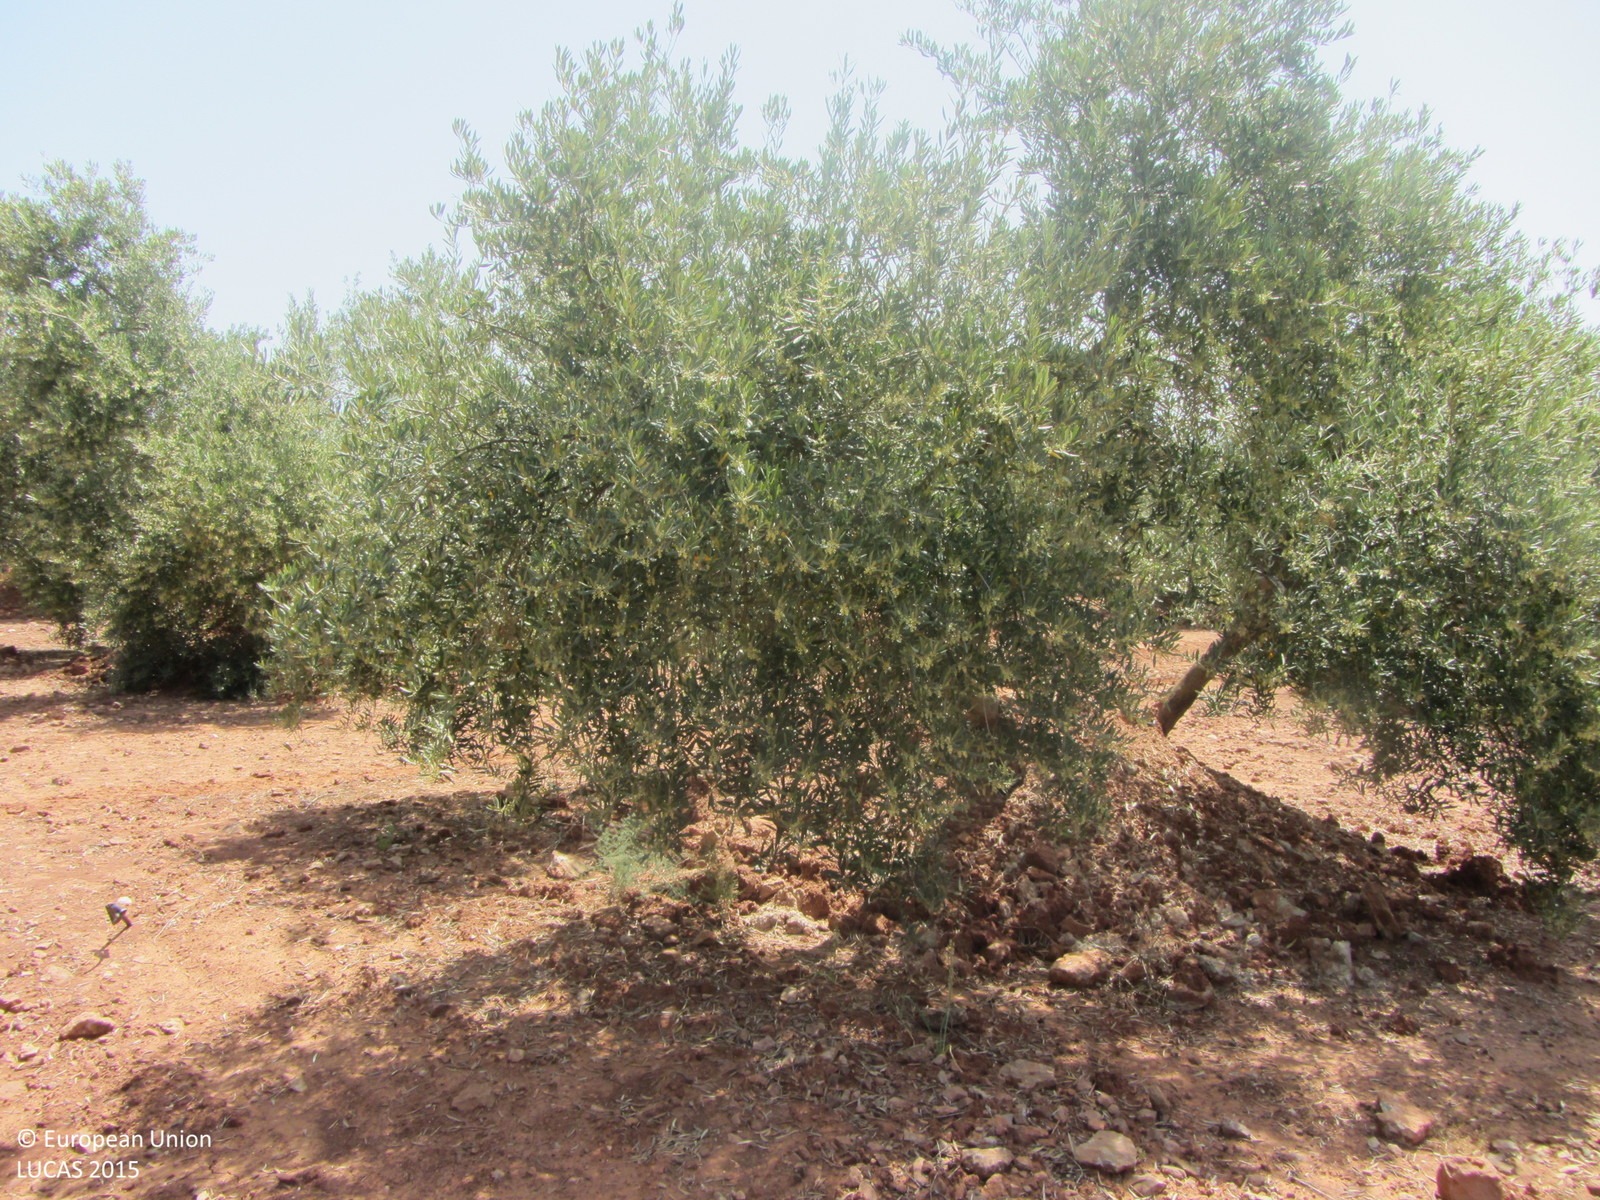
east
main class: Cropland
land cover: Olive groves
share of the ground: 50 - 75 %
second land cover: Other bare soil
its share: > 75 %
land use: Agriculture (excluding fallow land and kitchen gardens)
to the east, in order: Olive groves; Other bare soil; Shruby margins; Rivers and streams; Shruby margins; Olive groves; Shrubland without tree cover; Olive groves
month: May
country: ES
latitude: 38.2784
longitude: -3.0209
